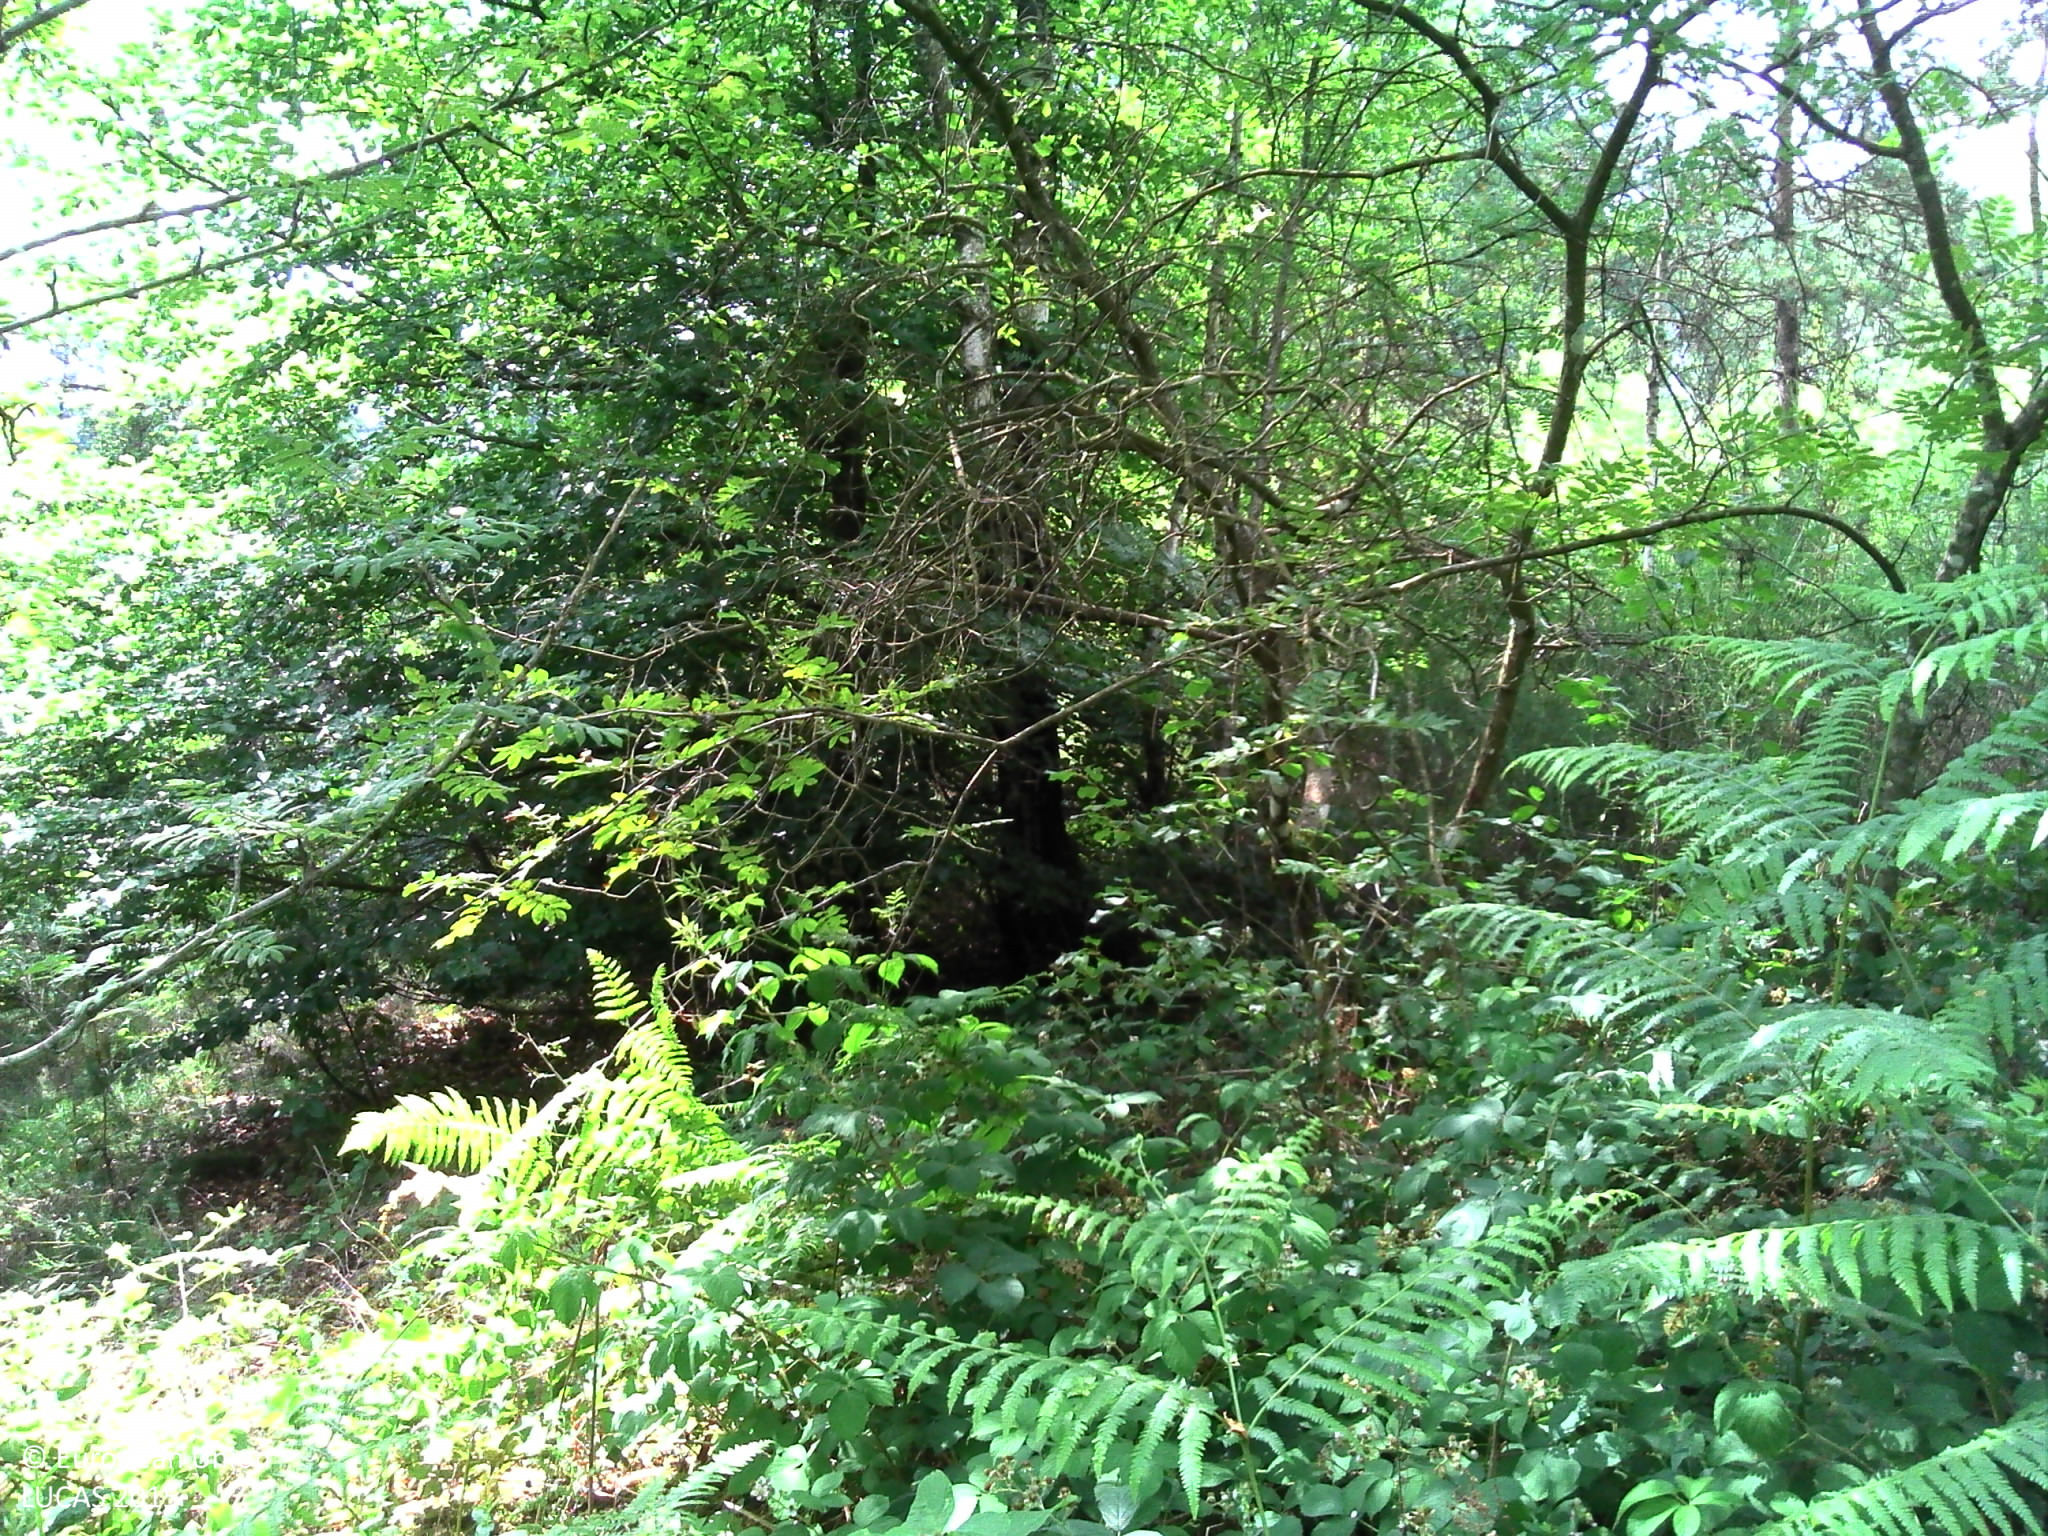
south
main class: Woodland
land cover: Broadleaved woodland
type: non-riverine alder, birch or aspen forest
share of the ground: > 75 %
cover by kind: broadleaved forest trees 40 %, herbaceous plants 40 %, lichens and mosses 20 %
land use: Forestry
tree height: < 5 m
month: July
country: FR
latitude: 45.7846
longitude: 1.8265
